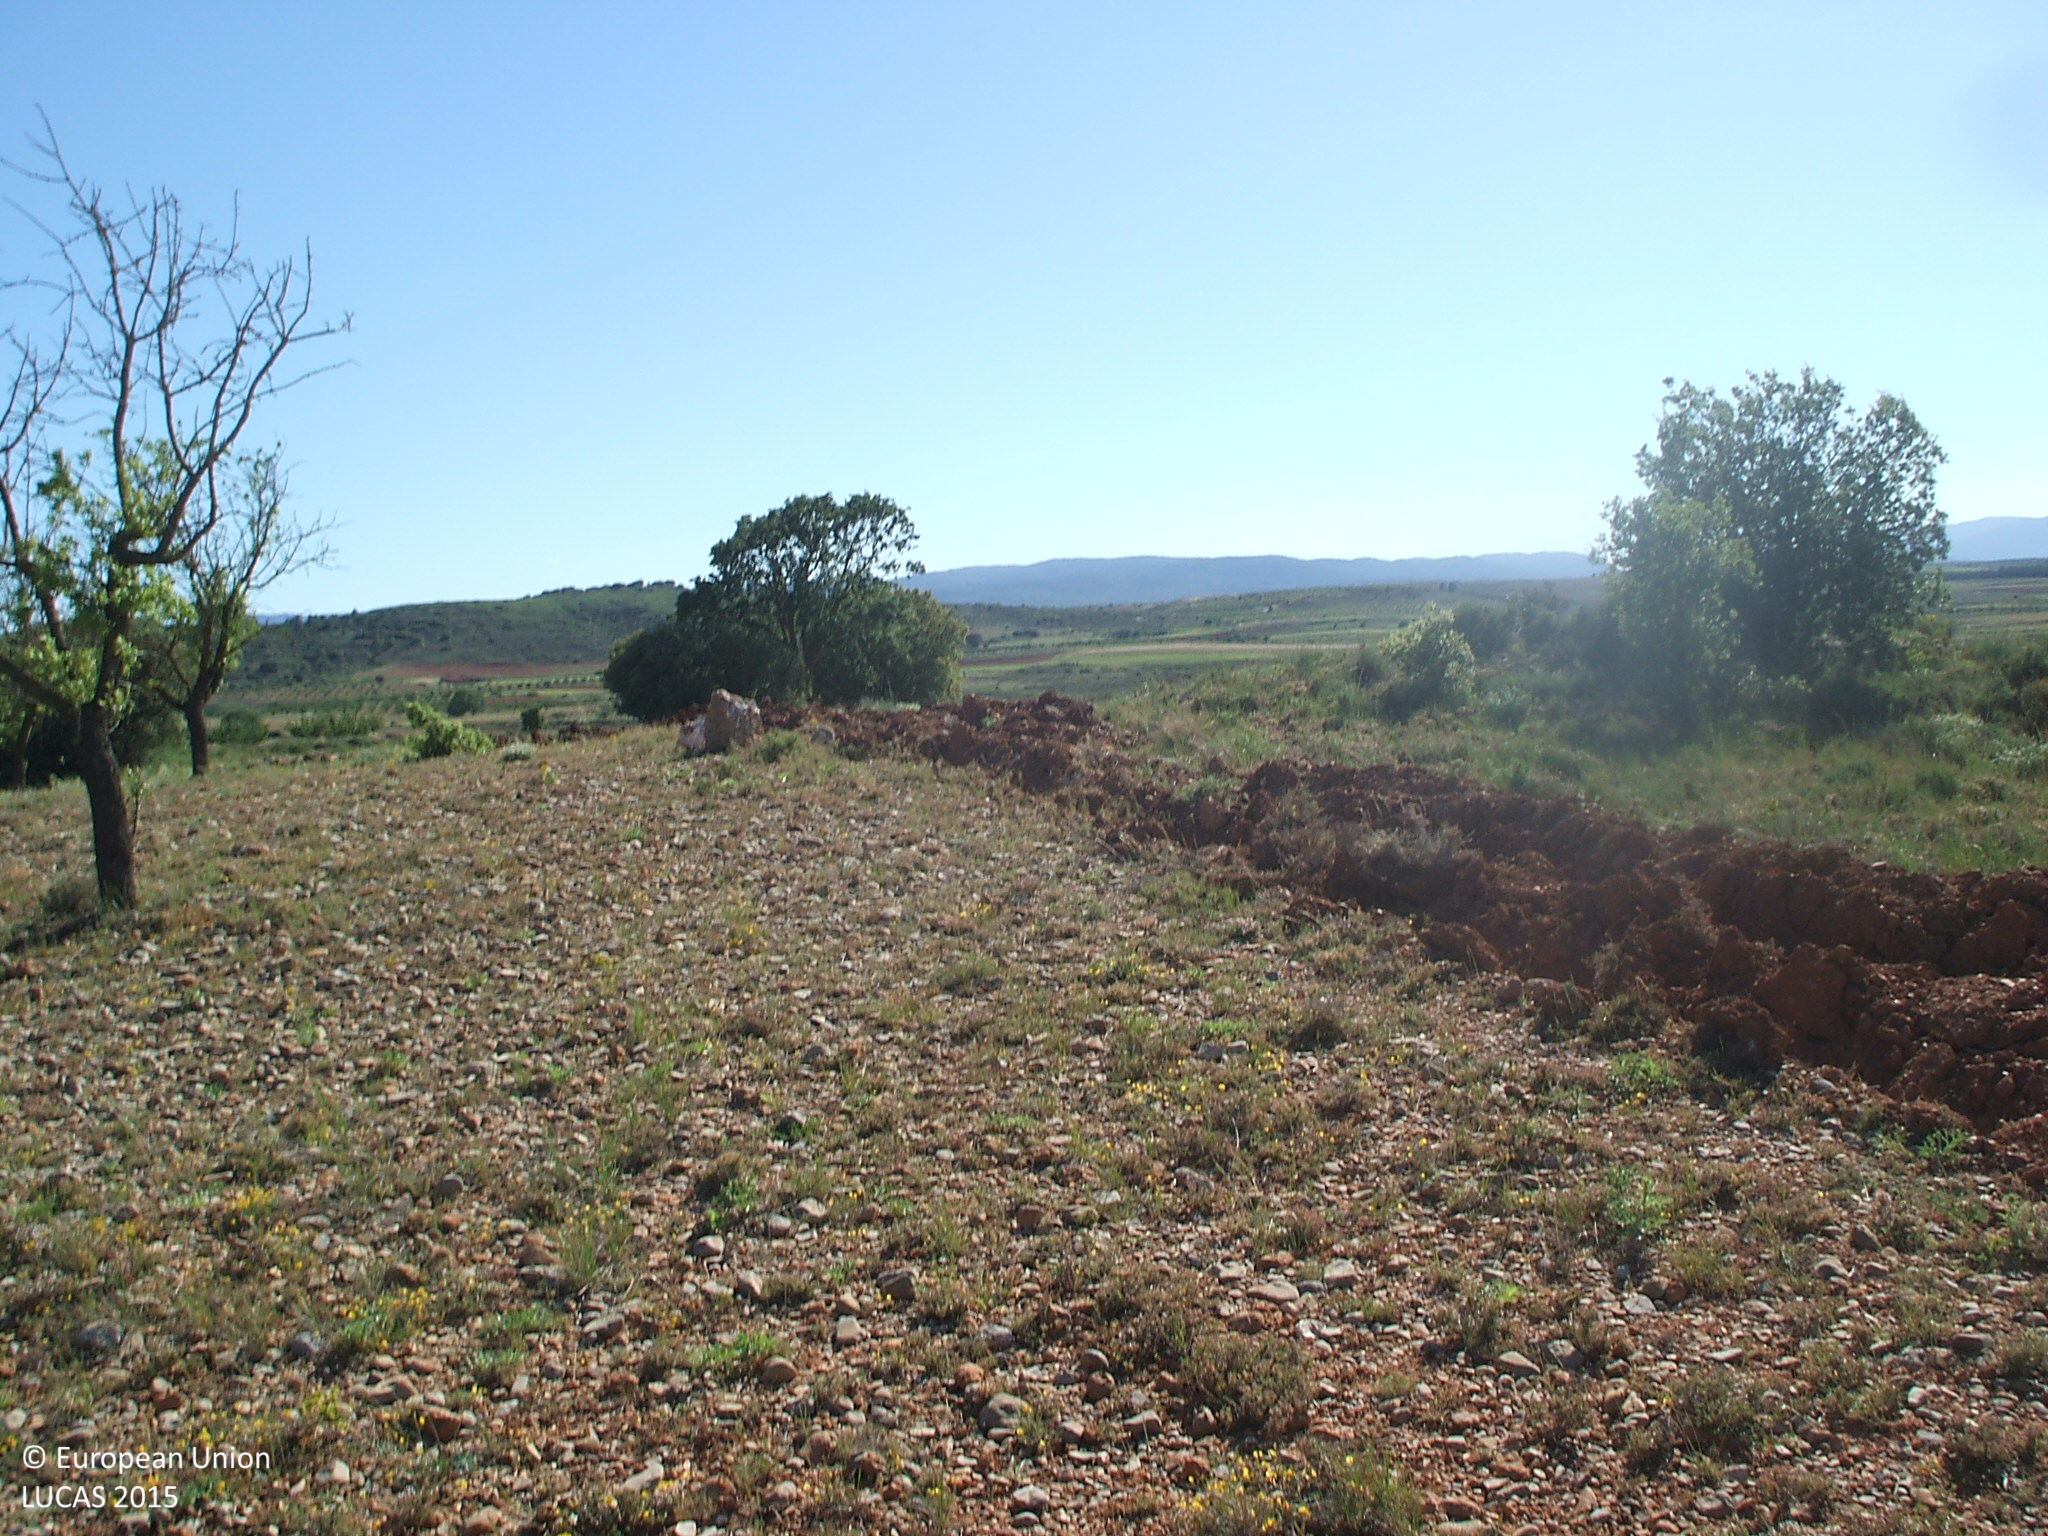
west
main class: Cropland
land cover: Nuts trees
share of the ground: 10 - 25 %
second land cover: Spontaneously vegetated surfaces
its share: 25 - 50 %
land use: Agriculture (excluding fallow land and kitchen gardens)
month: May
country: ES
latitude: 40.0829
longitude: -0.6890
